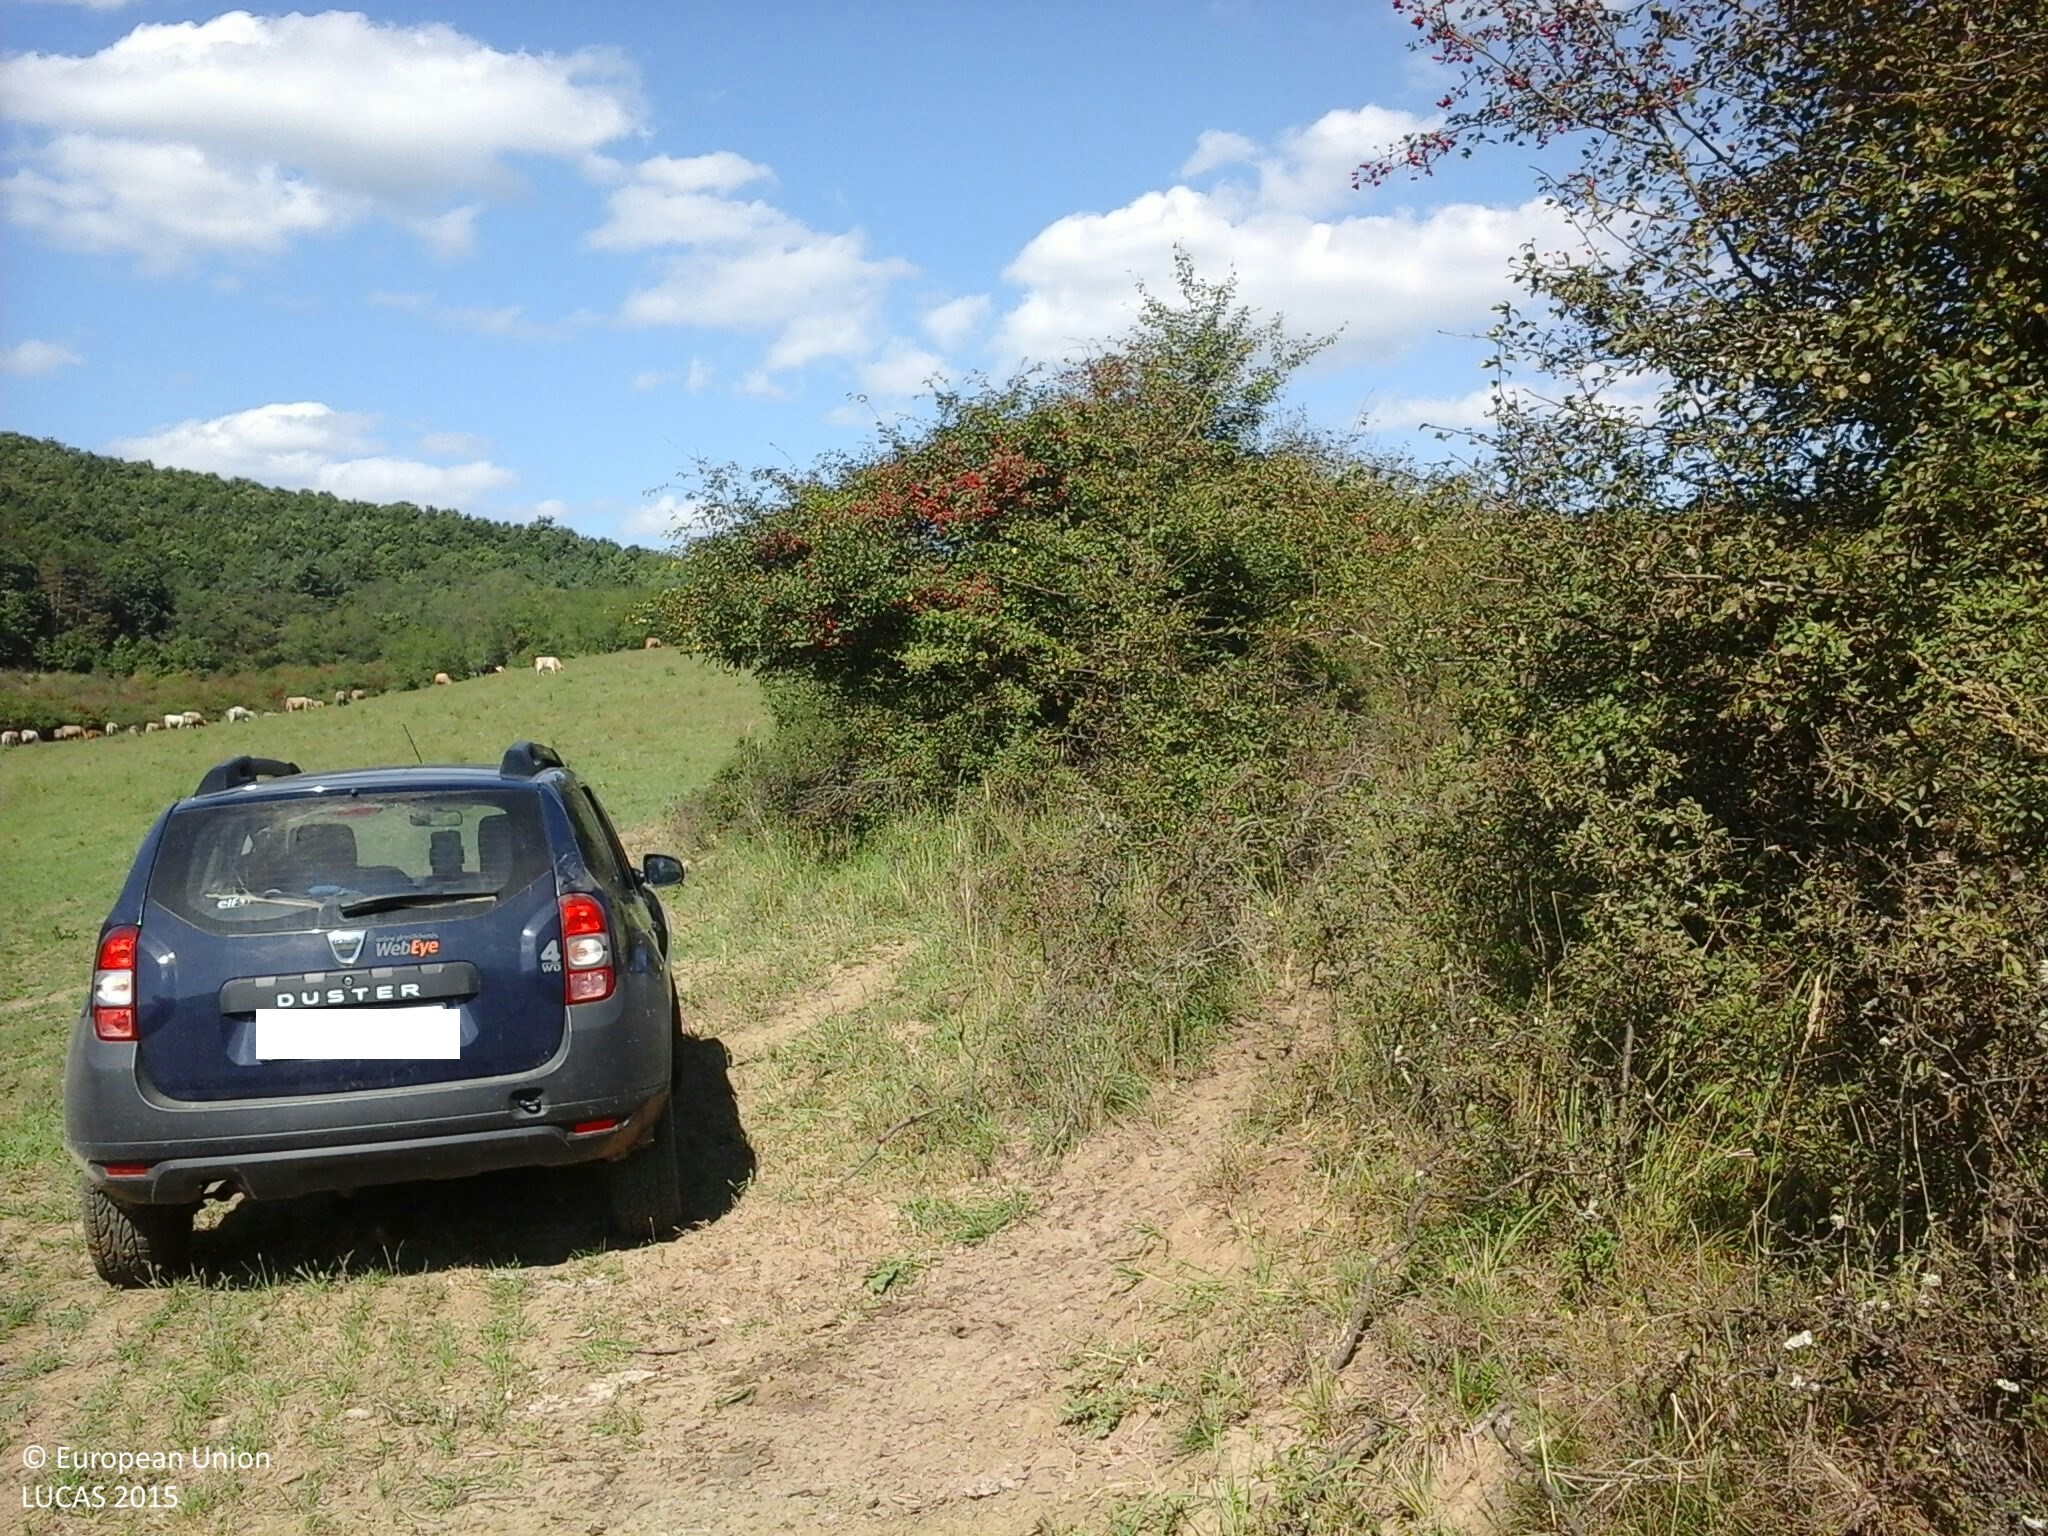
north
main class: Shrubland
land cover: Shrubland with sparse tree cover
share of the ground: > 75 %
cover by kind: shrubs 90 %, broadleaved forest trees 5 %, herbaceous plants 5 %
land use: Agriculture (excluding fallow land and kitchen gardens)
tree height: < 5 m
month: September
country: HU
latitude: 48.0143
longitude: 19.8805
